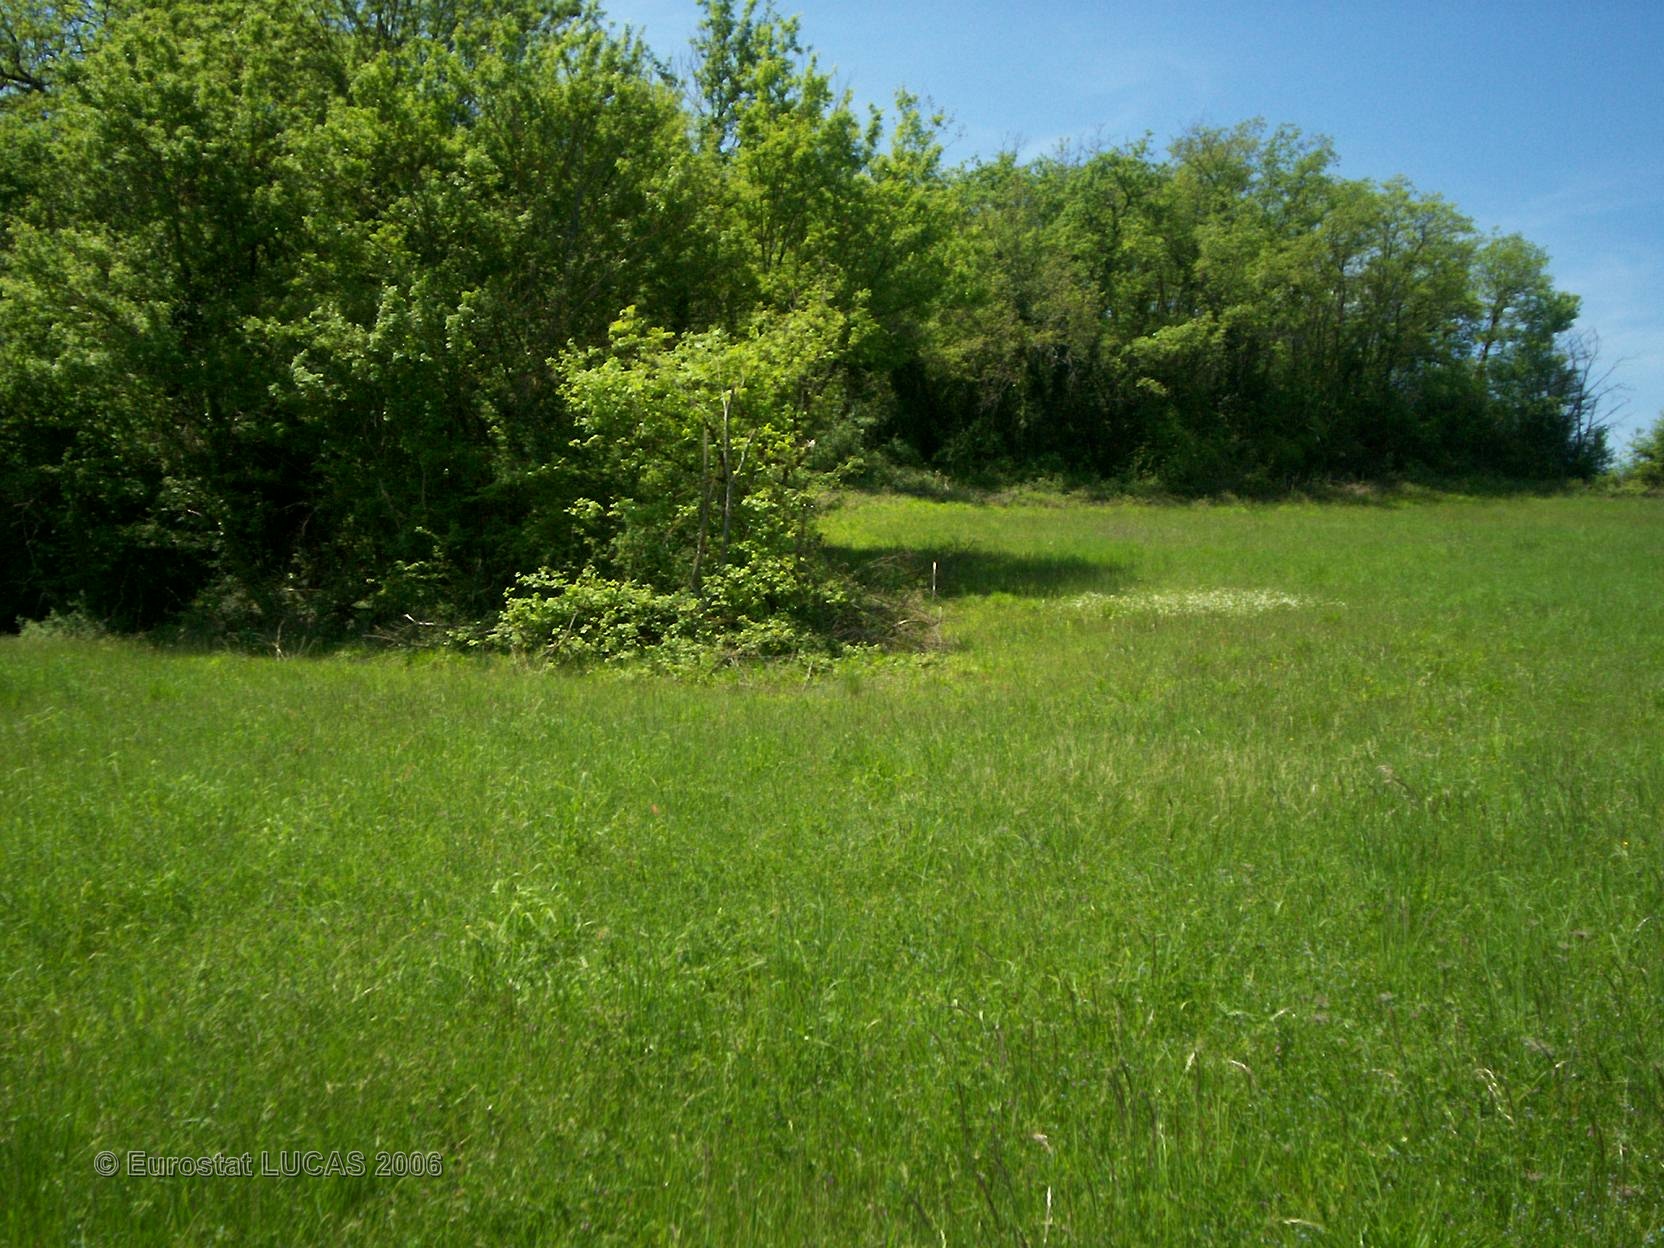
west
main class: Grassland
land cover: Grassland without tree/shrub cover
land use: Agriculture (excluding fallow land and kitchen gardens)
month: May
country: FR
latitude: 45.7320
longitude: 5.4679
